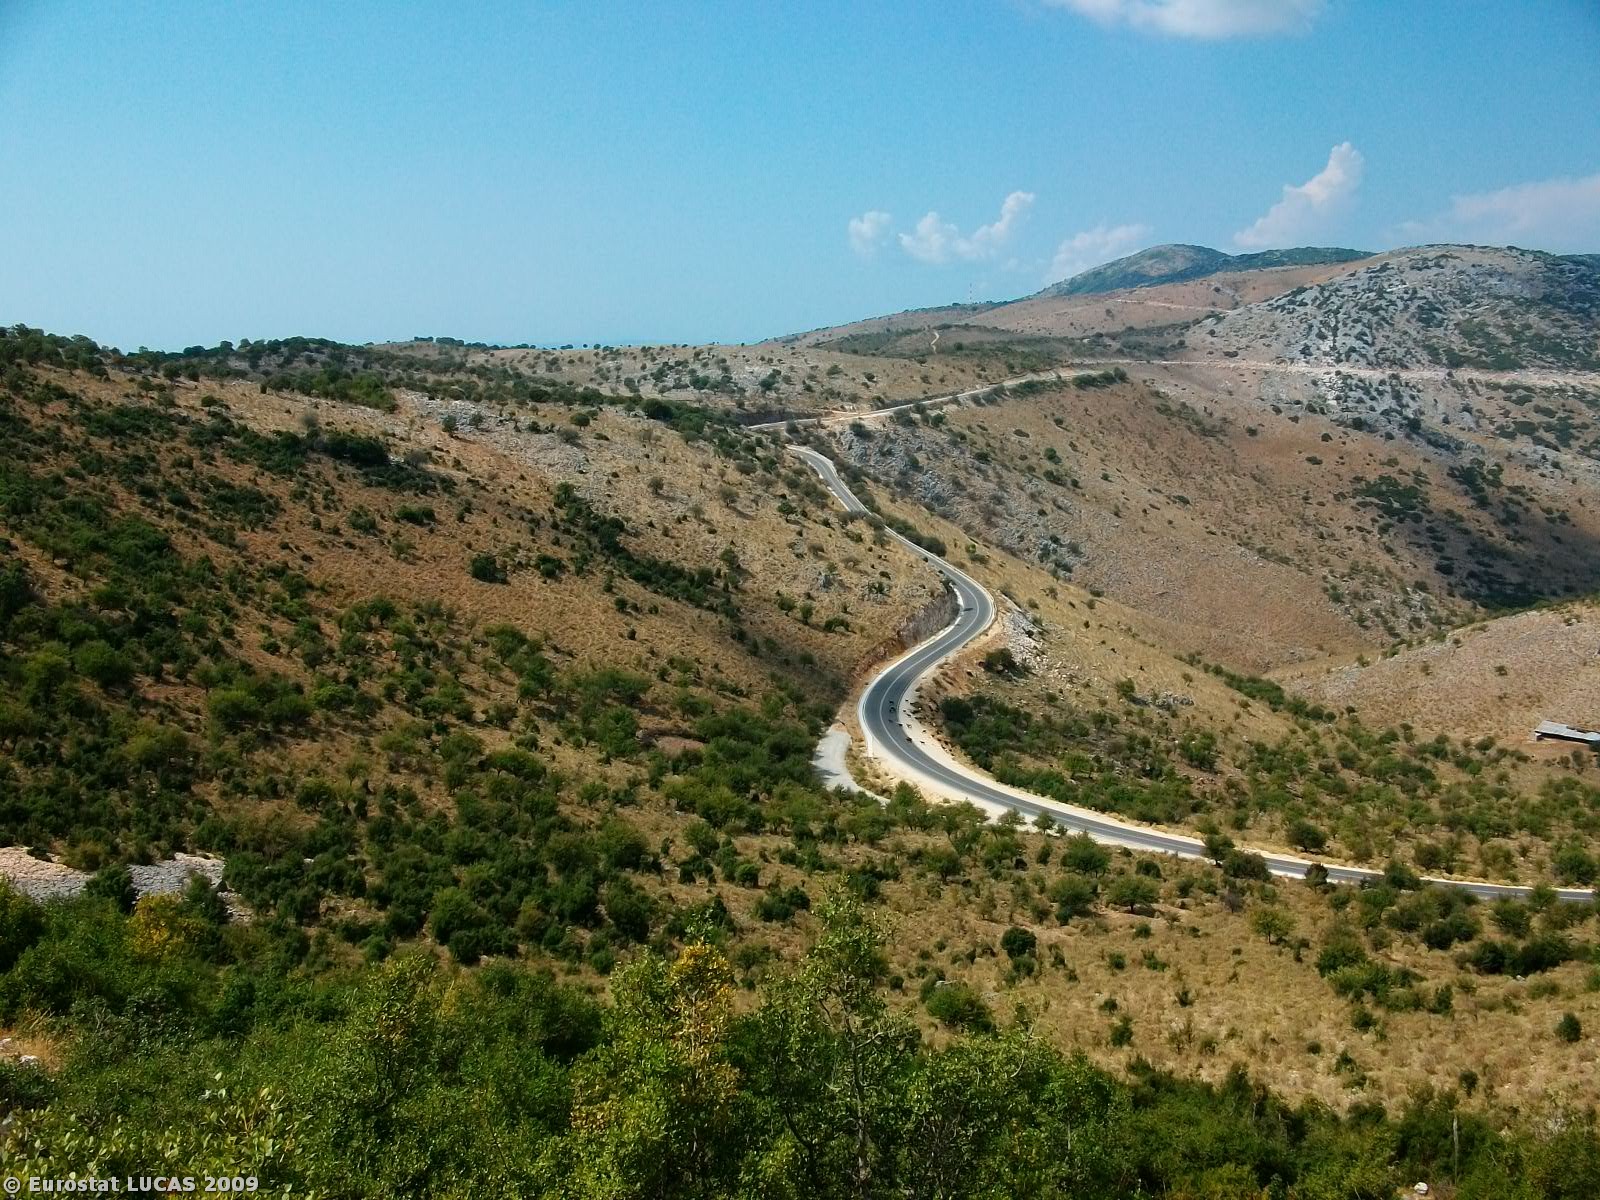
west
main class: Shrubland
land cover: Shrubland without tree cover
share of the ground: > 75 %
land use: Unused
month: September
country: GR
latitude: 39.3707
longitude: 20.3616
